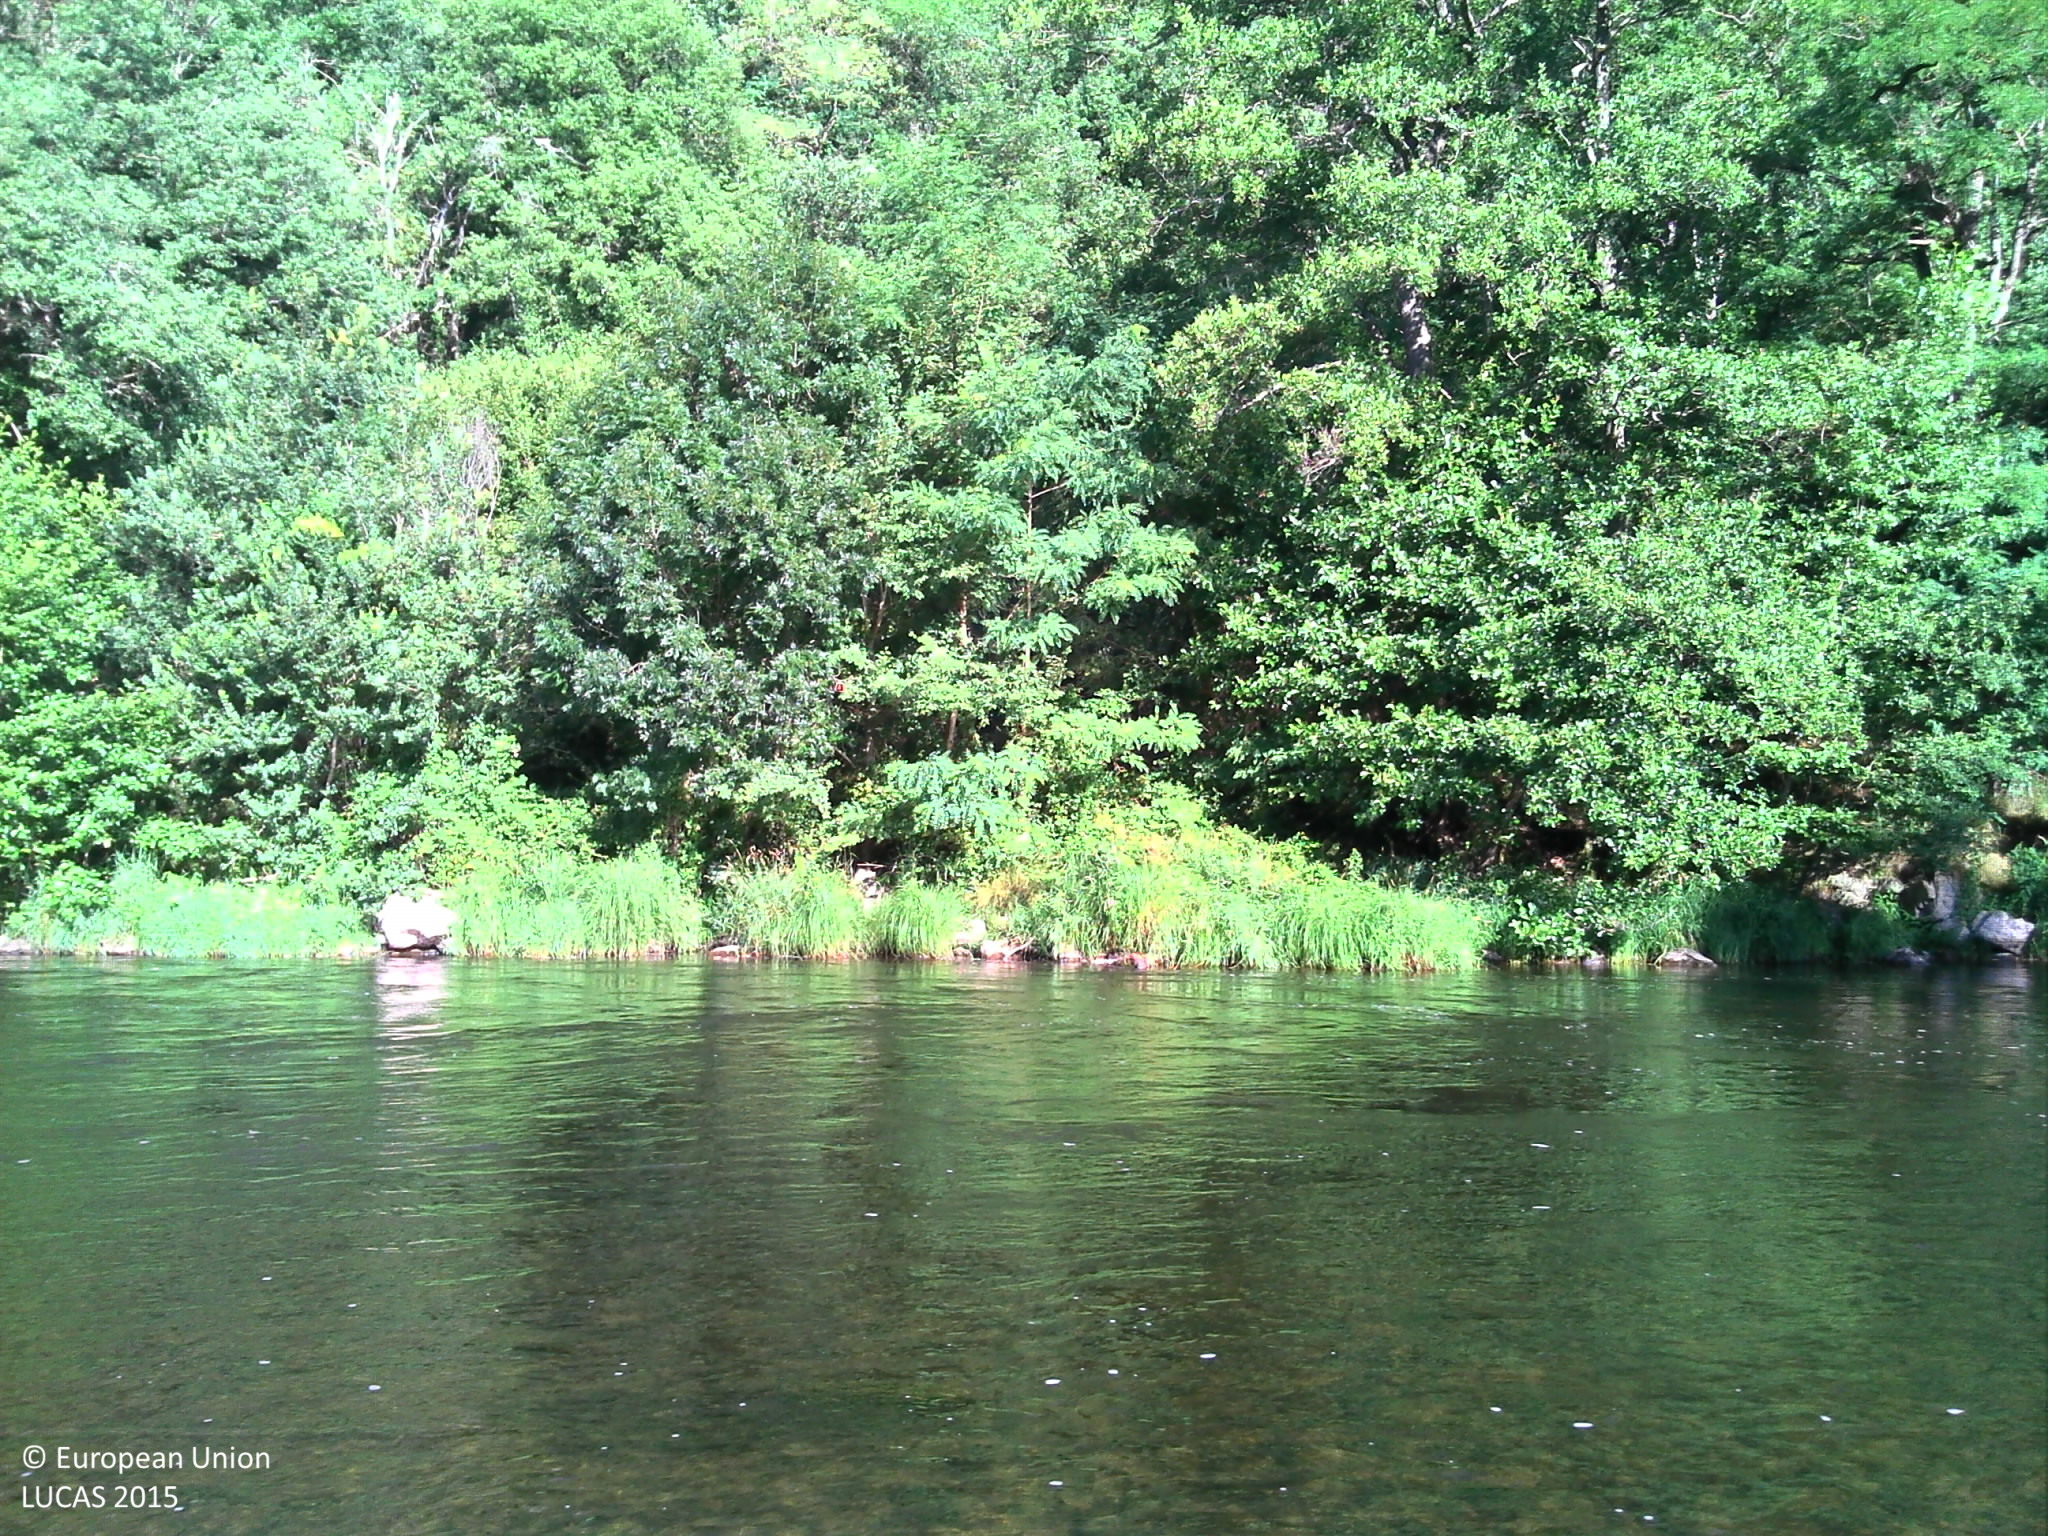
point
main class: Woodland
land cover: Broadleaved woodland
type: mesophytic deciduous forest
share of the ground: > 75 %
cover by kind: broadleaved forest trees 100 %
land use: Forestry
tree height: > 5 m
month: July
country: FR
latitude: 45.2250
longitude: 3.3926
